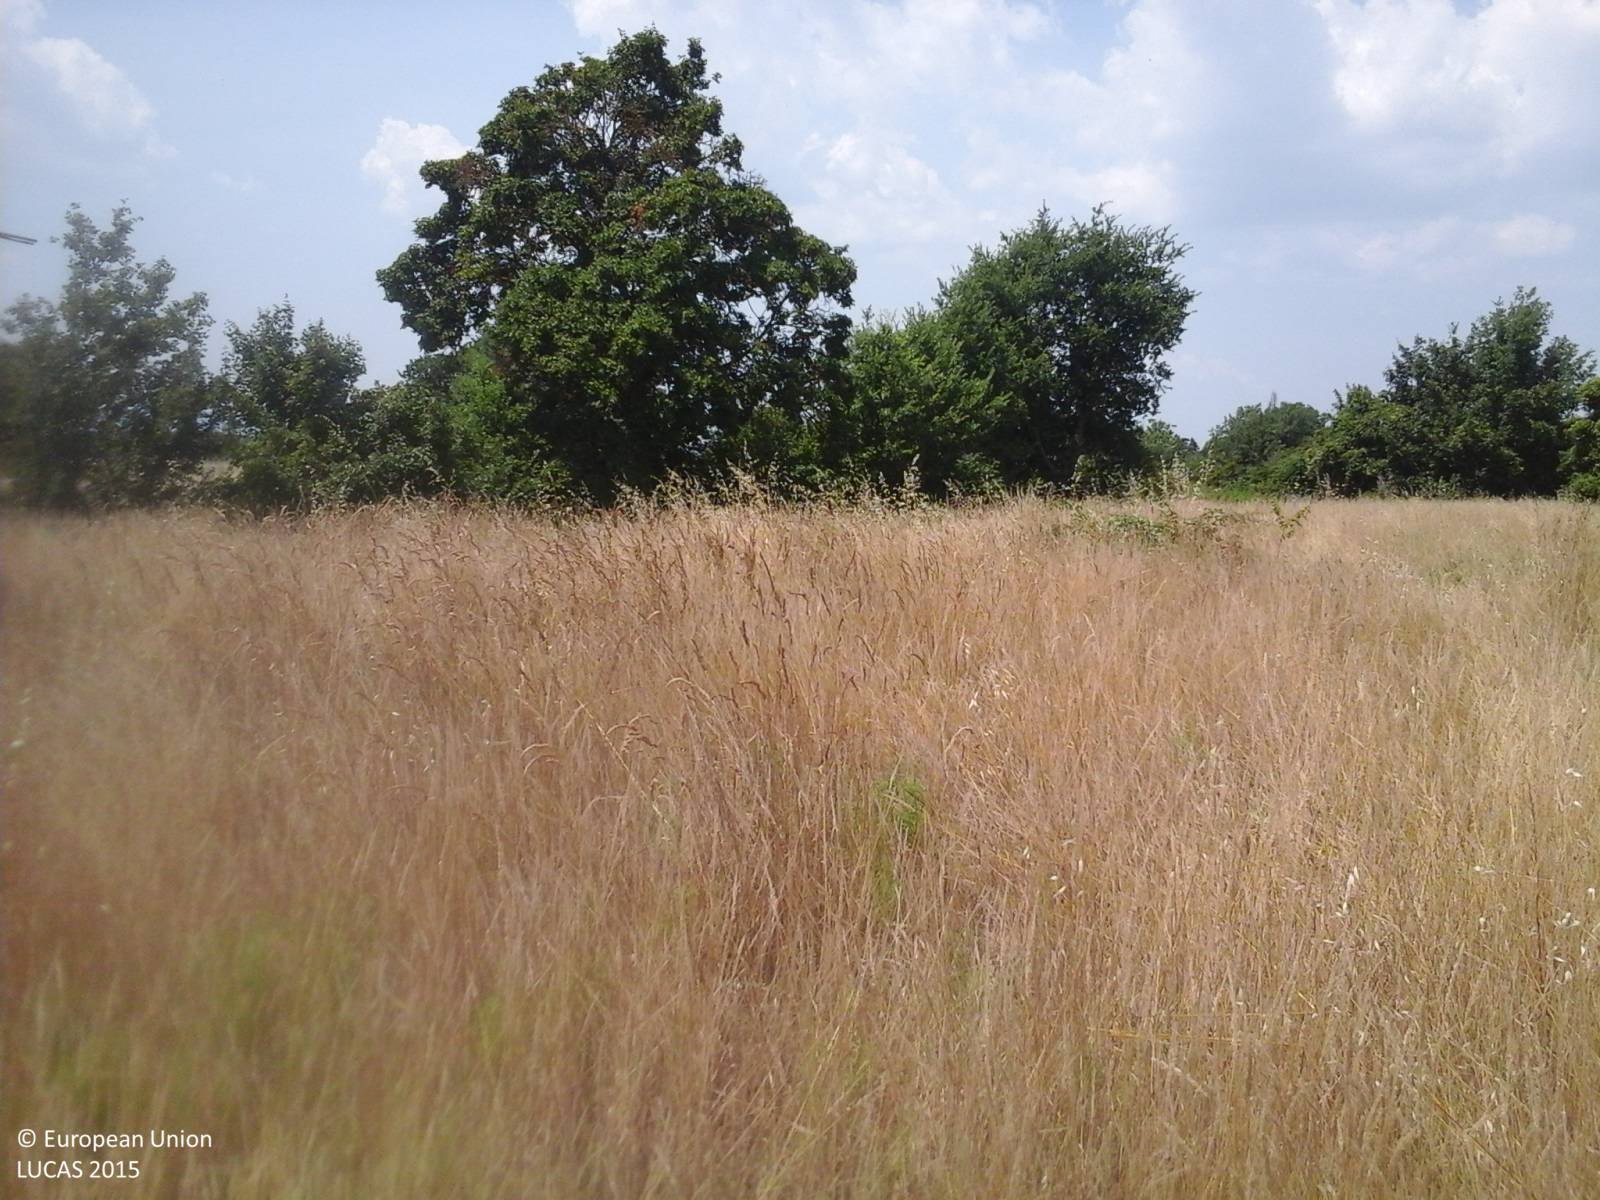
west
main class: Grassland
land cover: Spontaneously vegetated surfaces
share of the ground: > 75 %
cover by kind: herbaceous plants 100 %
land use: Fallow land
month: July
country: IT
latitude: 43.3589
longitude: 11.8826
